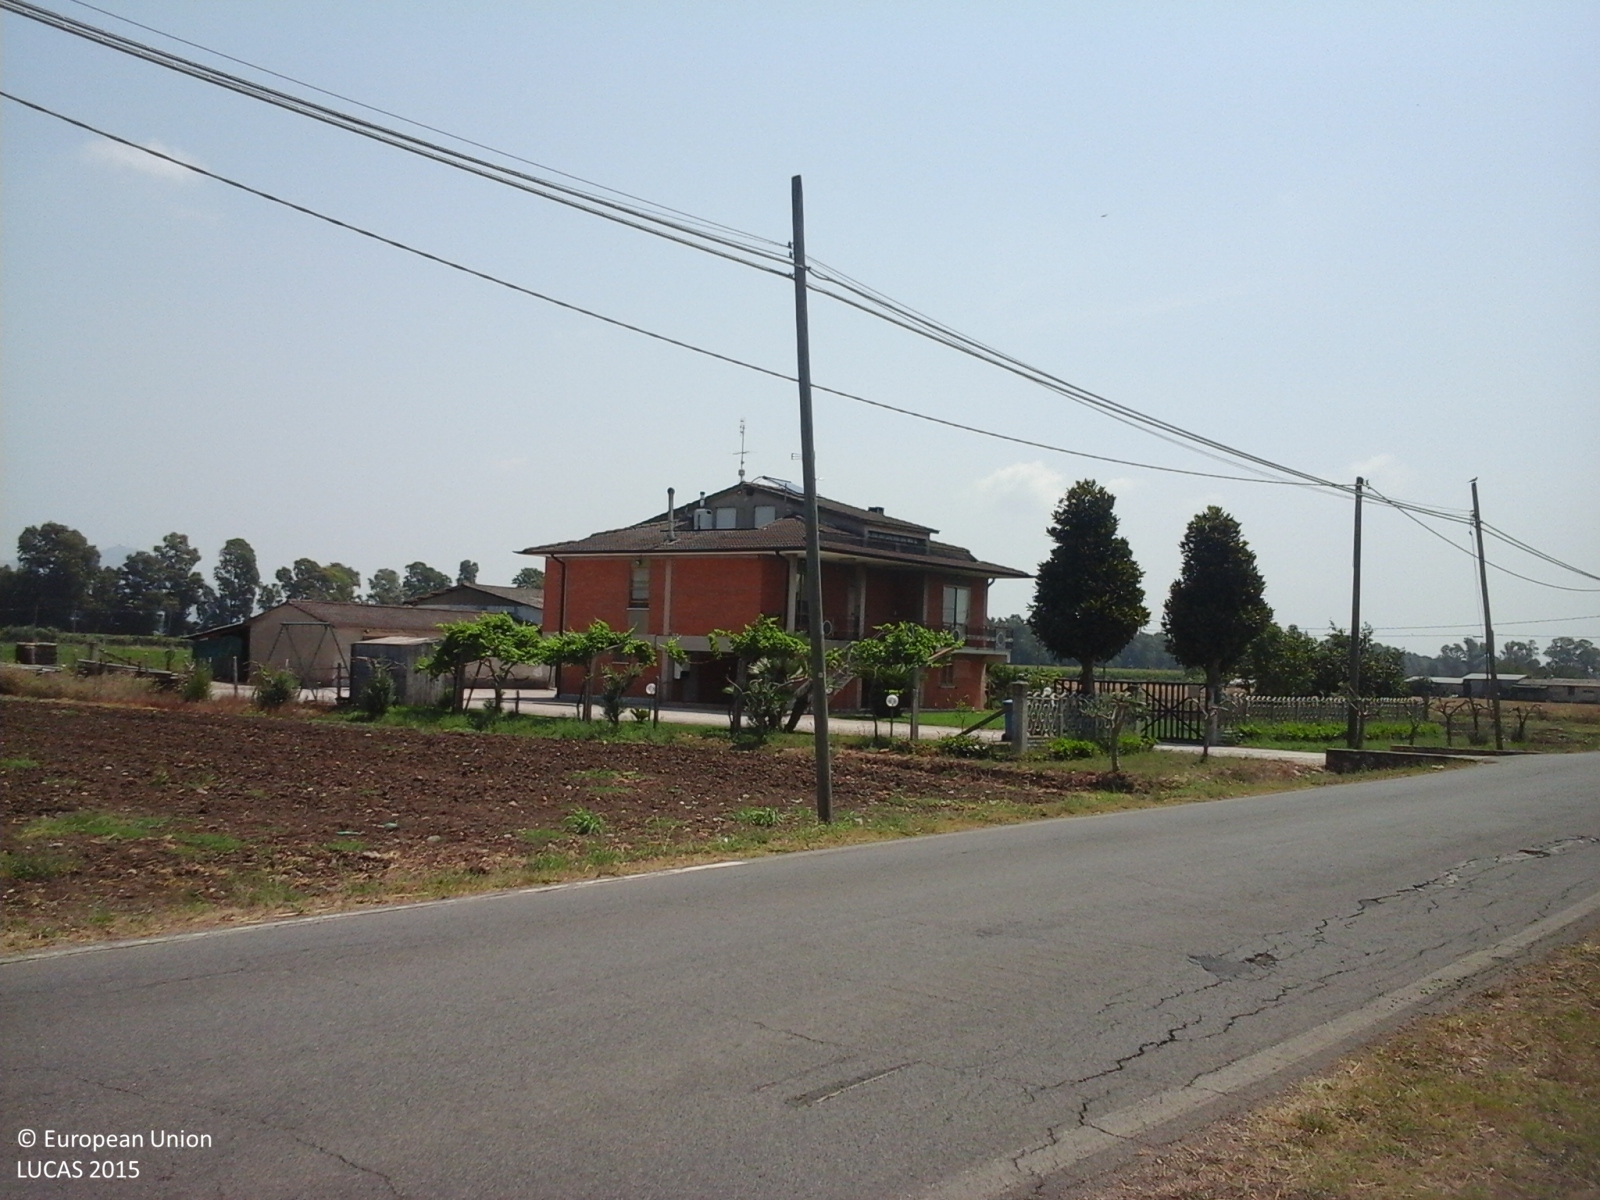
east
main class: Cropland
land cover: Olive groves
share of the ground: > 75 %
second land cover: Grassland without tree/shrub cover
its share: > 75 %
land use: Kitchen garden
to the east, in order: Olive groves; Grassland without tree/shrub cover; Artificial constructions; Grass margins; Electric lines; Ditches and canals; Grass margins; Paved roads, cycling and walking lanes; Grass margins; Electric lines; Ditches and canals; Electric lines; Other bare soil; Artificial constructions in urban areas; Lines of trees; Other bare soil; Tomatoes; Paved roads, cycling and walking lanes; Ditches and canals; Grass margins; Shruby margins; Ditches and canals; Durum wheat; Electric lines; Durum wheat; Other bare soil
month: July
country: IT
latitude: 41.4714
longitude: 12.9697
